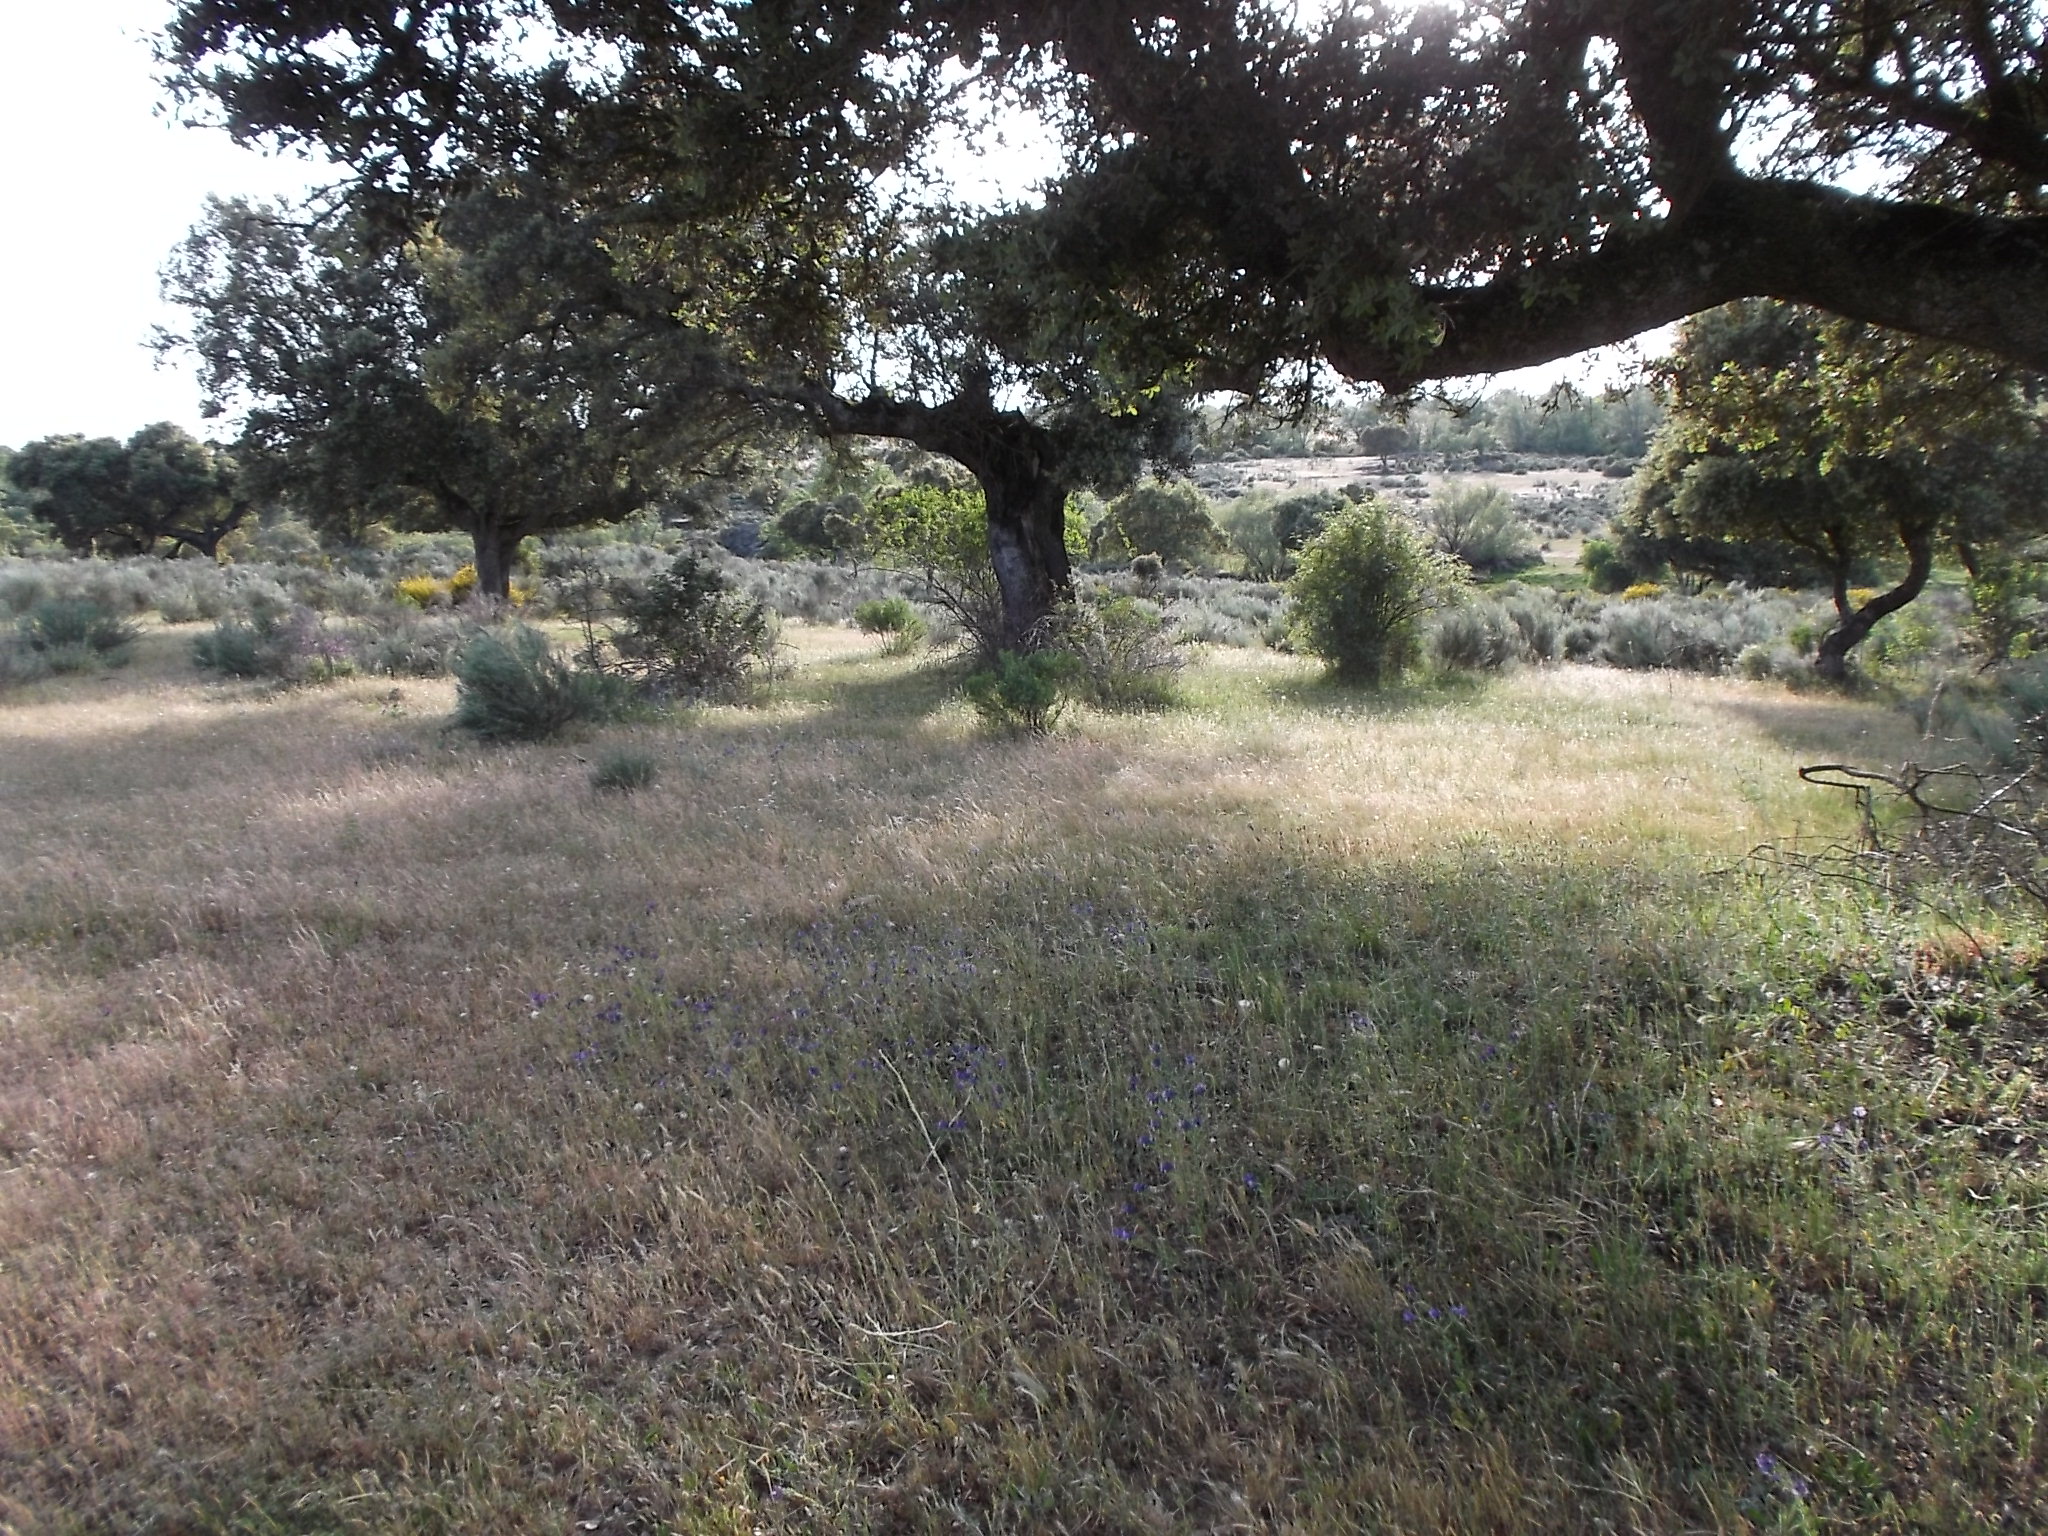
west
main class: Grassland
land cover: Grassland with sparse tree/shrub cover
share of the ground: > 75 %
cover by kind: herbaceous plants 90 %, broadleaved forest trees 5 %, shrubs 5 %
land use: Agriculture (excluding fallow land and kitchen gardens)
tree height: > 5 m
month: May
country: ES
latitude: 41.0676
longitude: -6.2884
